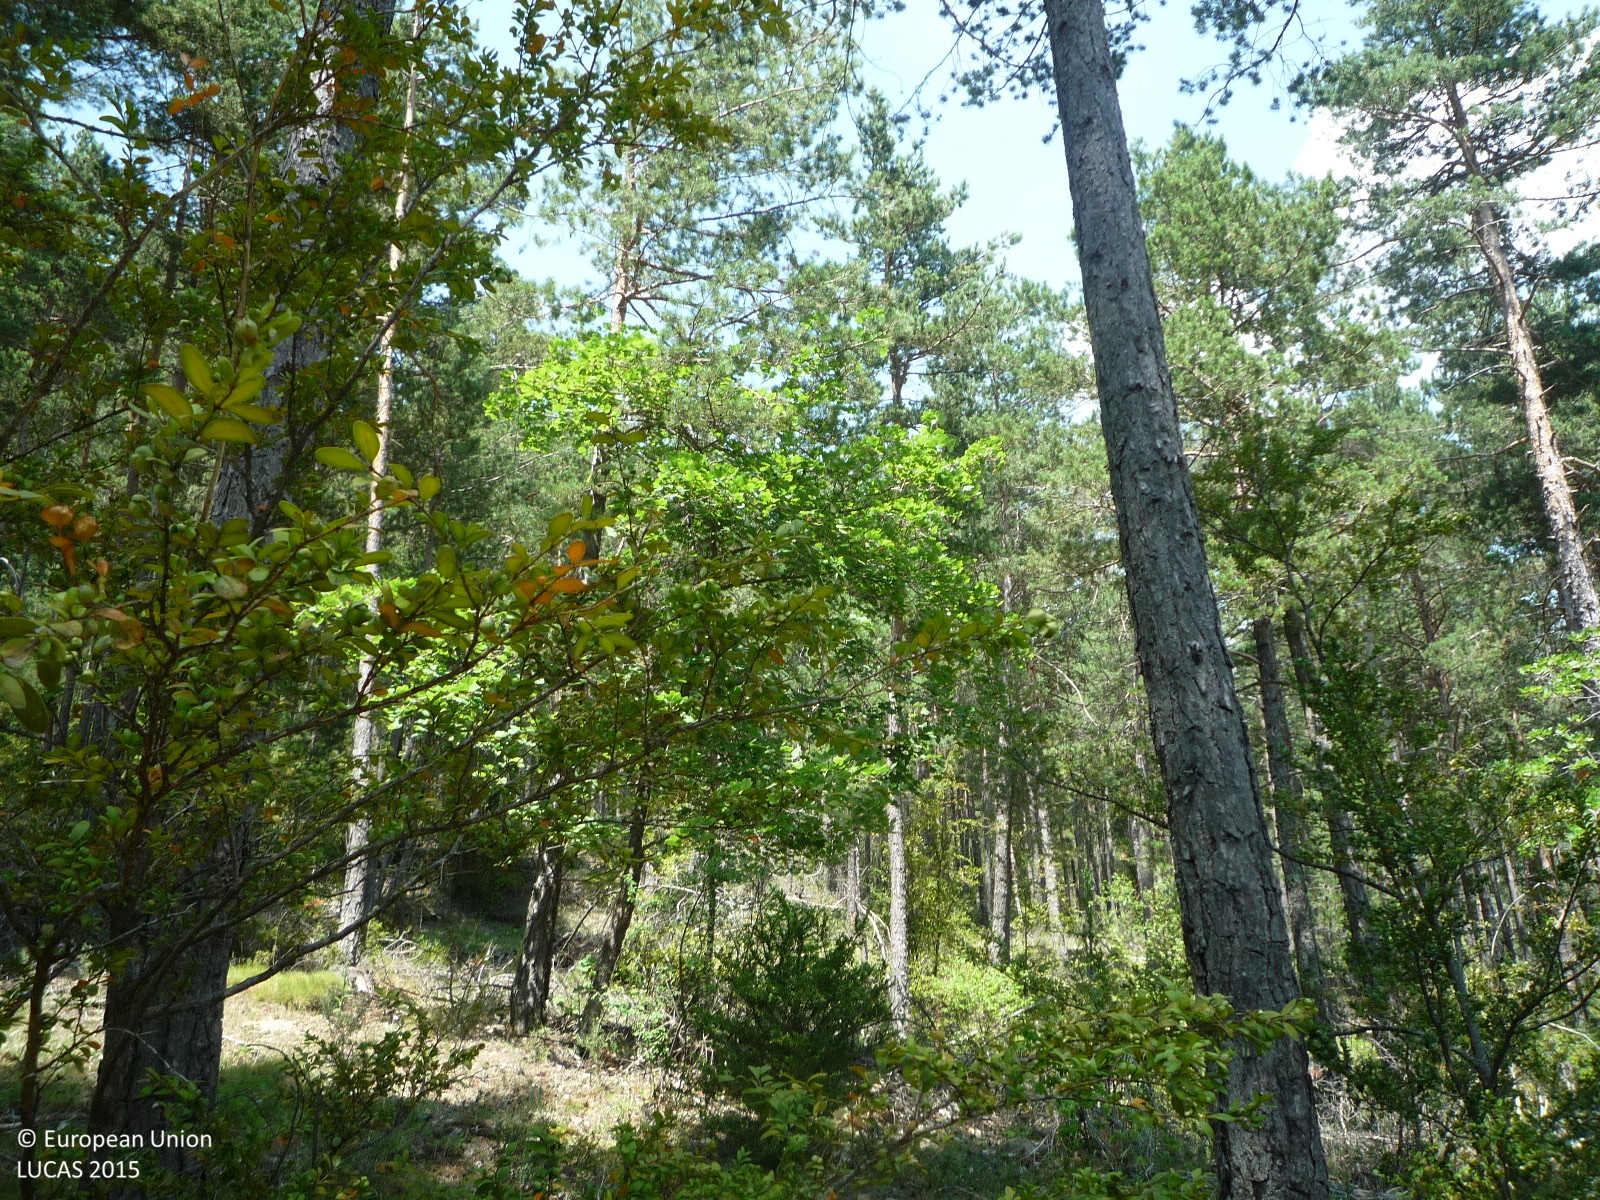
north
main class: Woodland
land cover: Pine dominated coniferous woodland
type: alpine coniferous forest
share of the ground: > 75 %
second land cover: Grassland without tree/shrub cover
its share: > 75 %
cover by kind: coniferous forest trees 80 %, herbaceous plants 20 %
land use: Forestry
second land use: Agriculture (excluding fallow land and kitchen gardens)
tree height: > 5 m
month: July
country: ES
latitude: 42.2033
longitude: 1.6912
